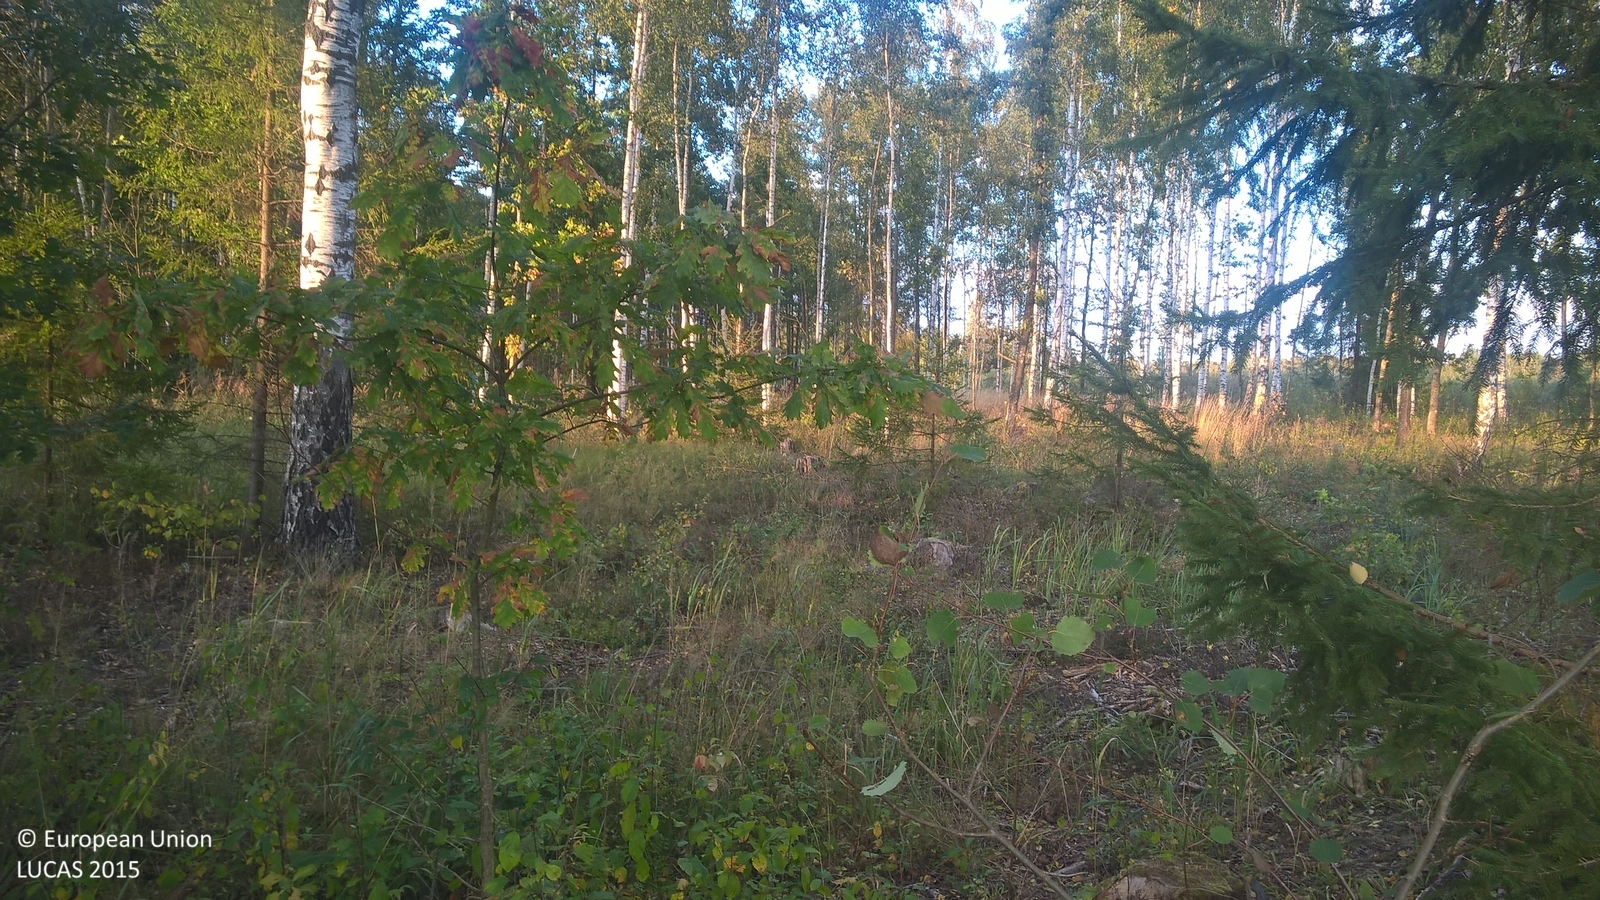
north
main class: Woodland
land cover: Broadleaved woodland
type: non-riverine alder, birch or aspen forest
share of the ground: 50 - 75 %
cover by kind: broadleaved forest trees 60 %, lichens and mosses 30 %, shrubs 10 %
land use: Forestry
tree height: > 5 m
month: September
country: LV
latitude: 57.6745
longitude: 25.6960
